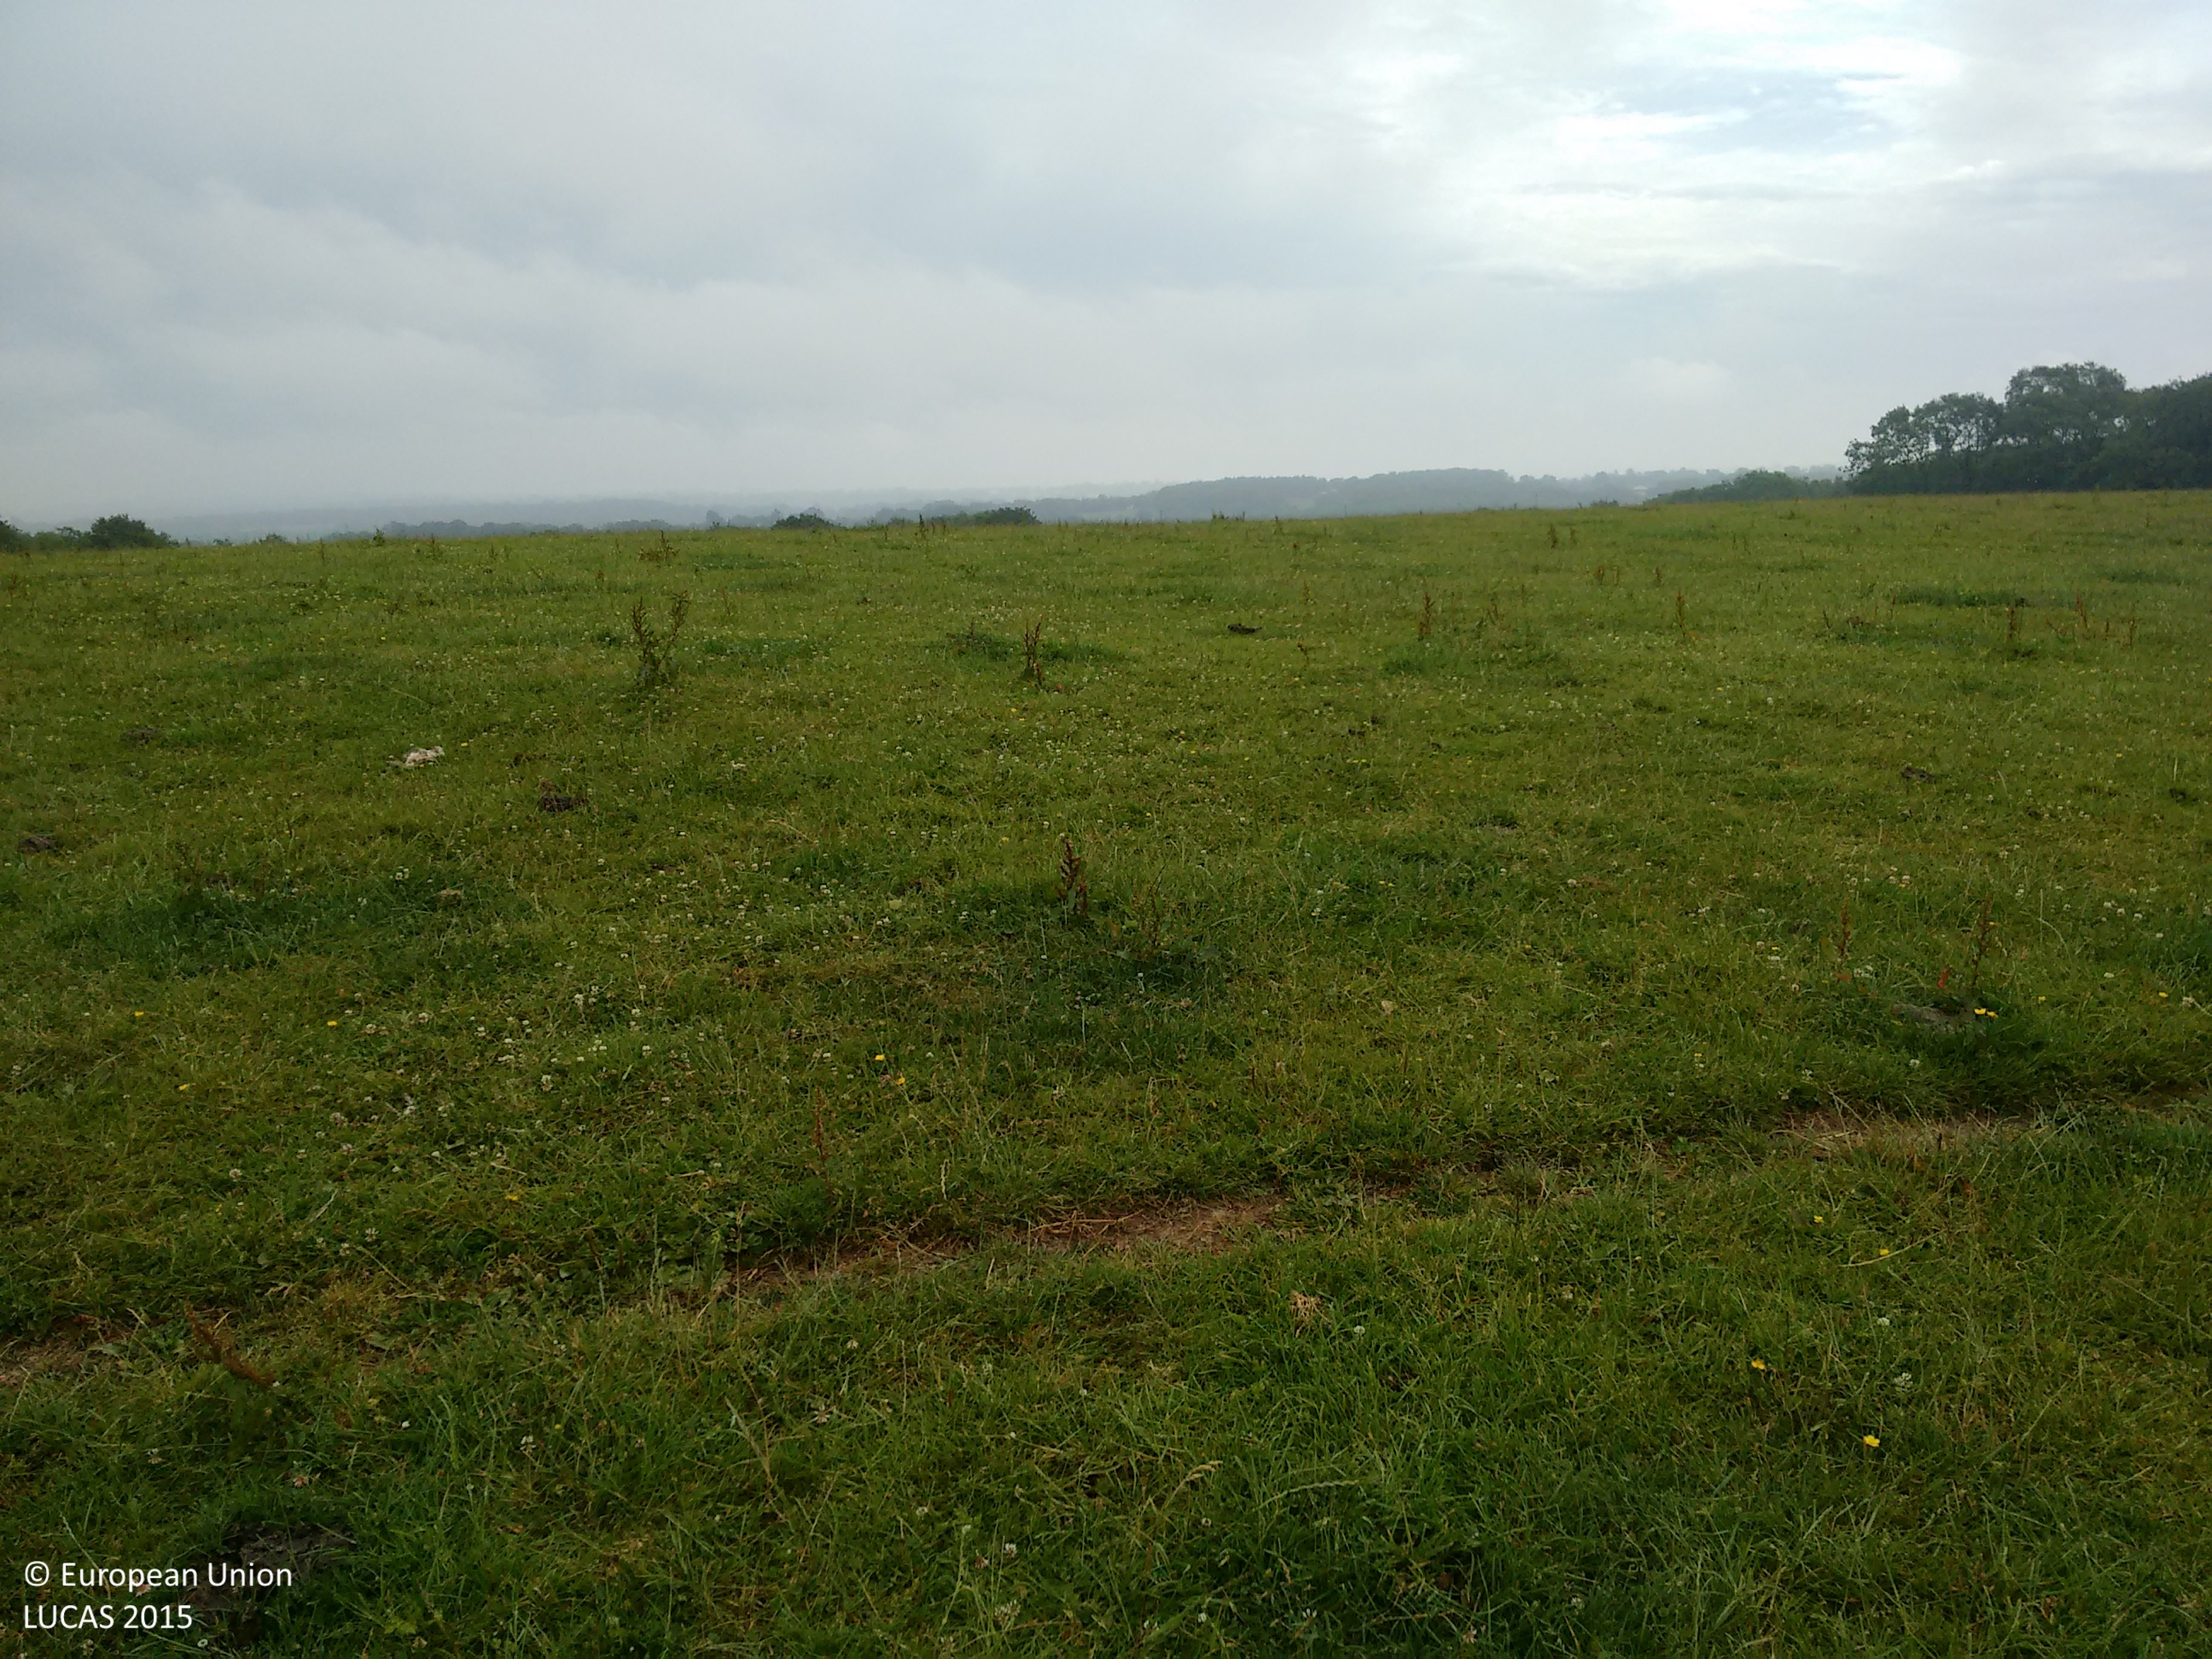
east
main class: Grassland
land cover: Grassland without tree/shrub cover
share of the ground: > 75 %
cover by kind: herbaceous plants 100 %
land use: Agriculture (excluding fallow land and kitchen gardens)
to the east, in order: Grassland without tree/shrub cover; Fences; Maize
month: July
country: GB
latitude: 51.0533
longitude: -0.1491
